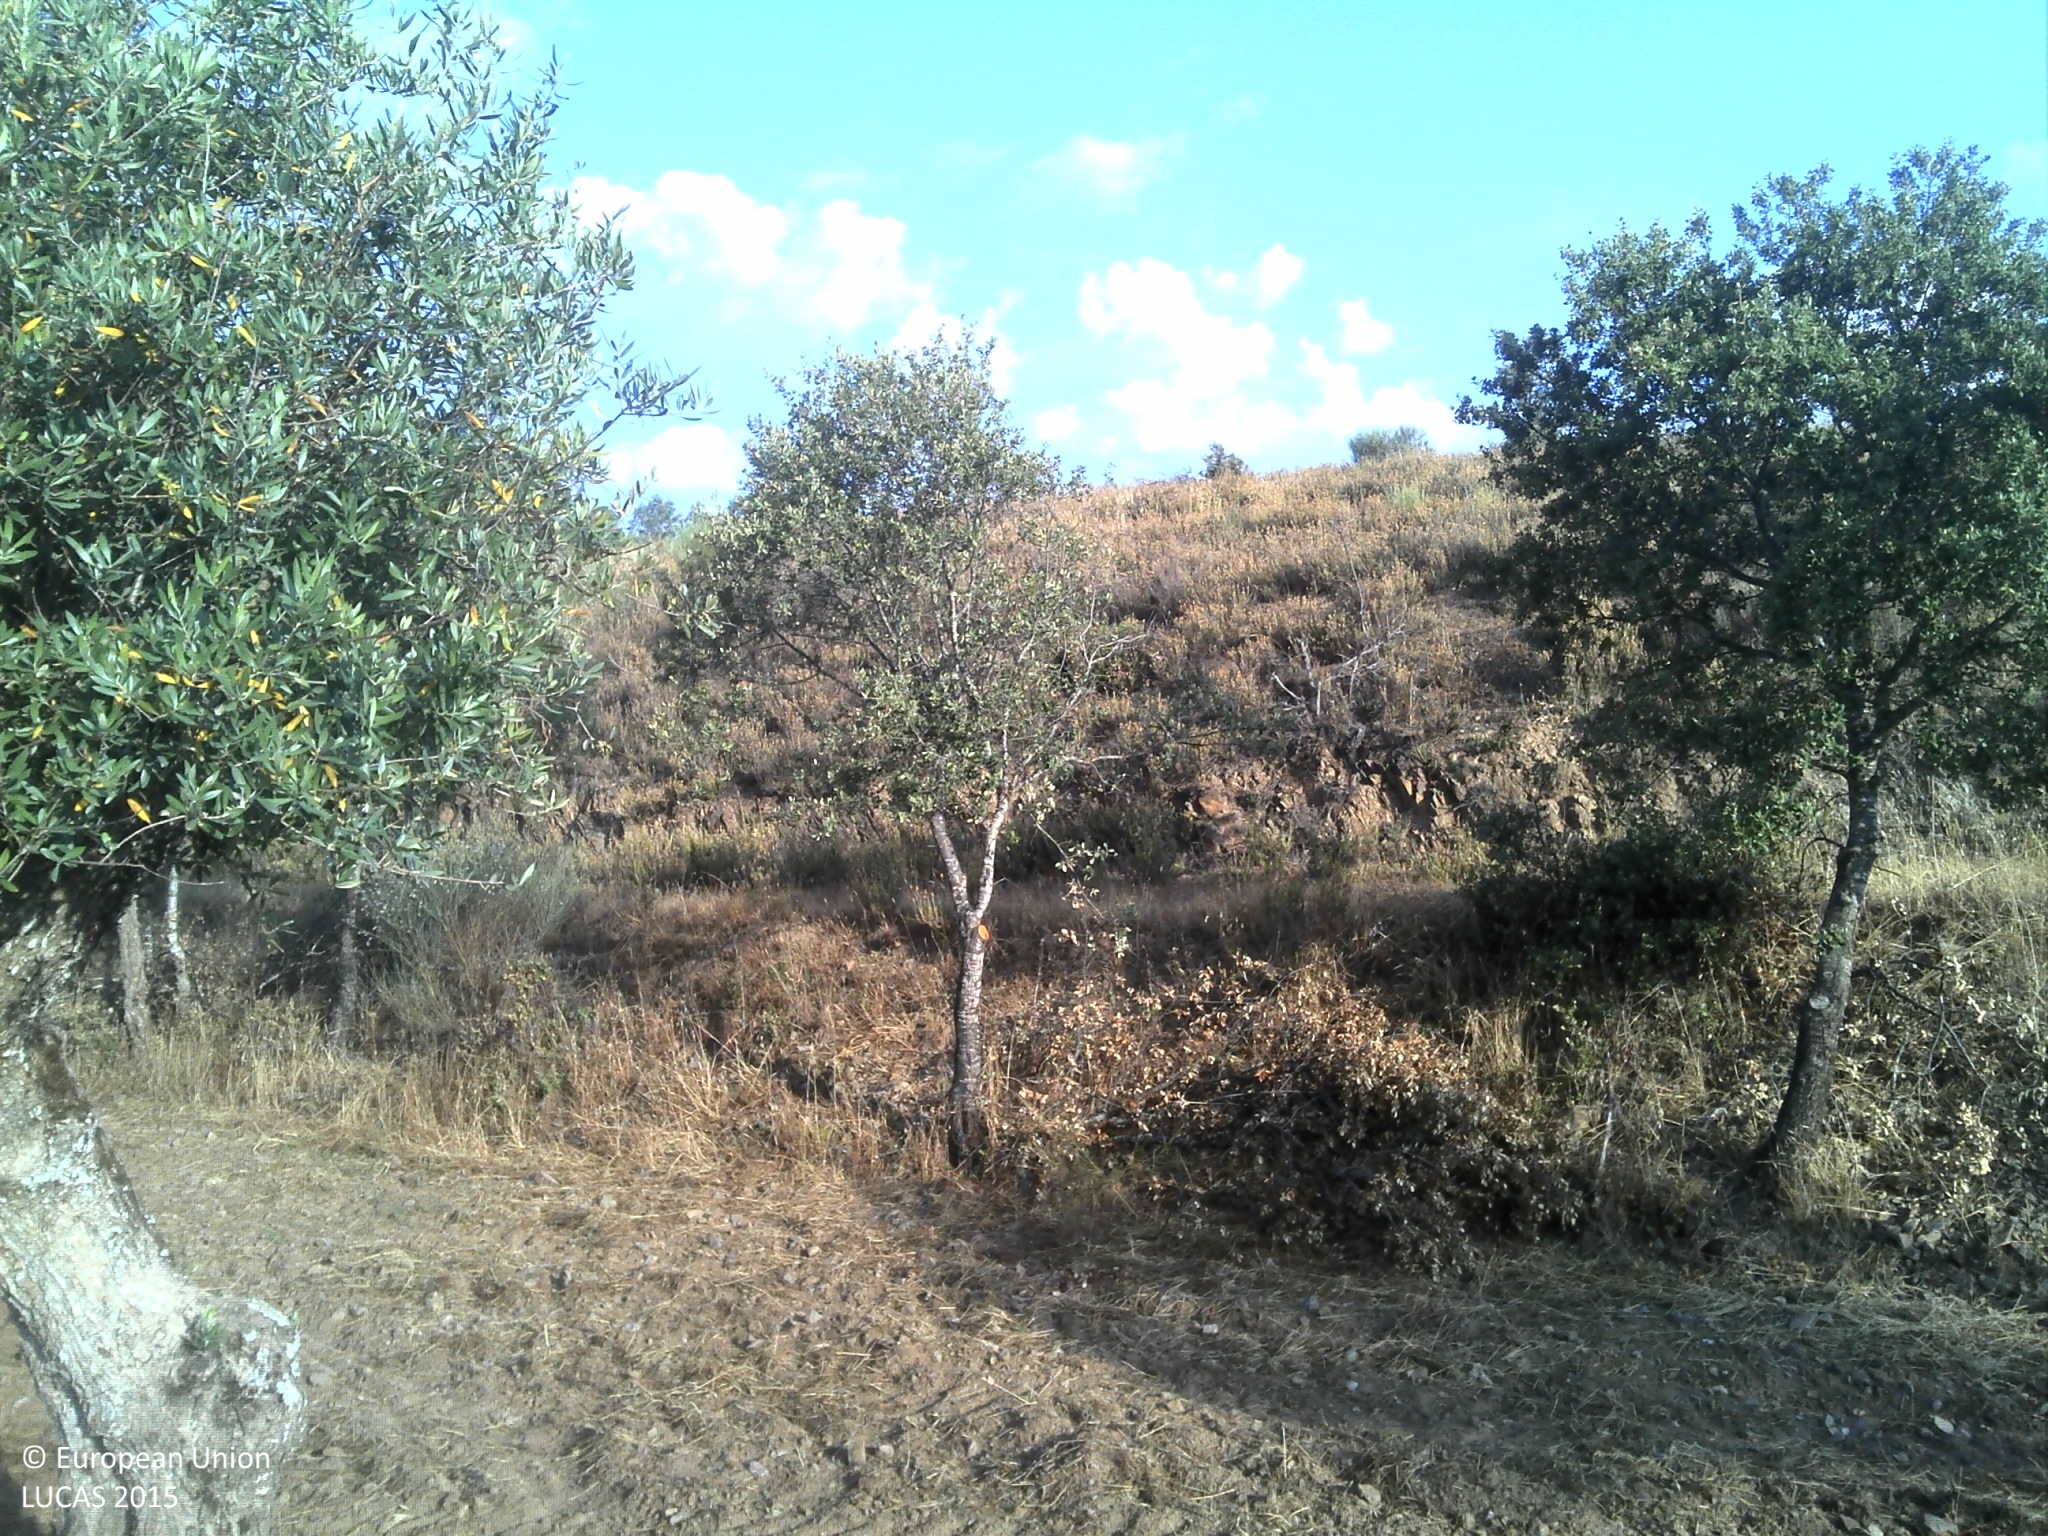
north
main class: Cropland
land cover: Olive groves
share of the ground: 25 - 50 %
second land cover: Spontaneously vegetated surfaces
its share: 25 - 50 %
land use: Agriculture (excluding fallow land and kitchen gardens)
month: June
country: PT
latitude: 40.1188
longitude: -7.0967
